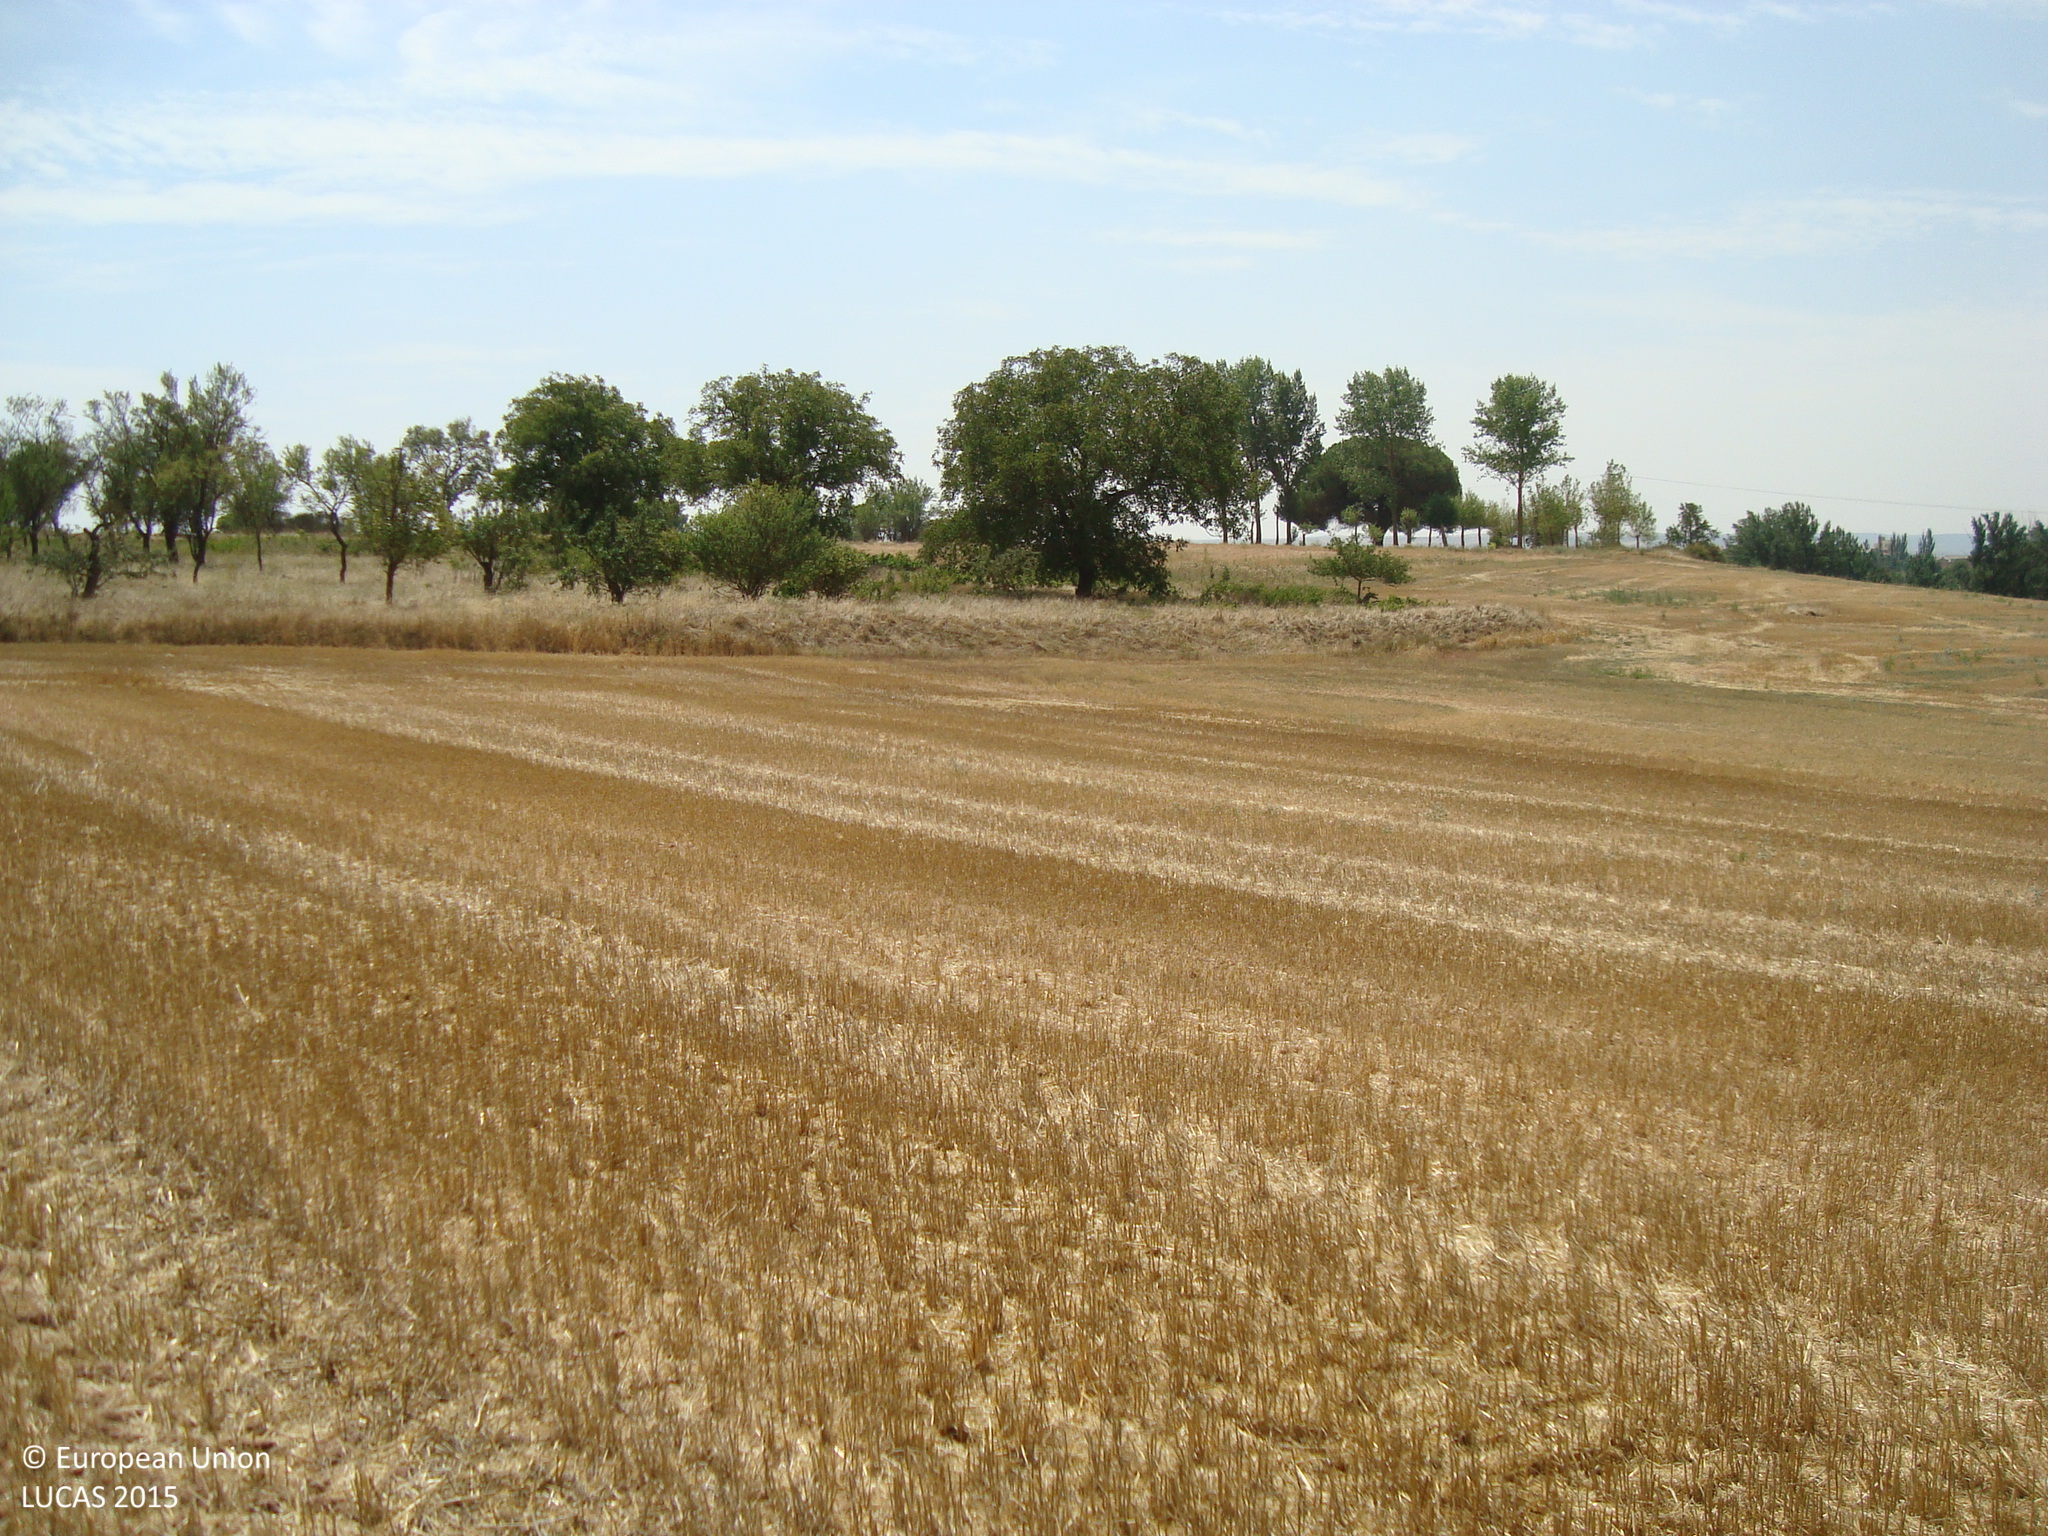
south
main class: Cropland
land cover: Common wheat
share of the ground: > 75 %
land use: Agriculture (excluding fallow land and kitchen gardens)
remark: Harvested field
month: August
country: ES
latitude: 42.1388
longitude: -3.9642
